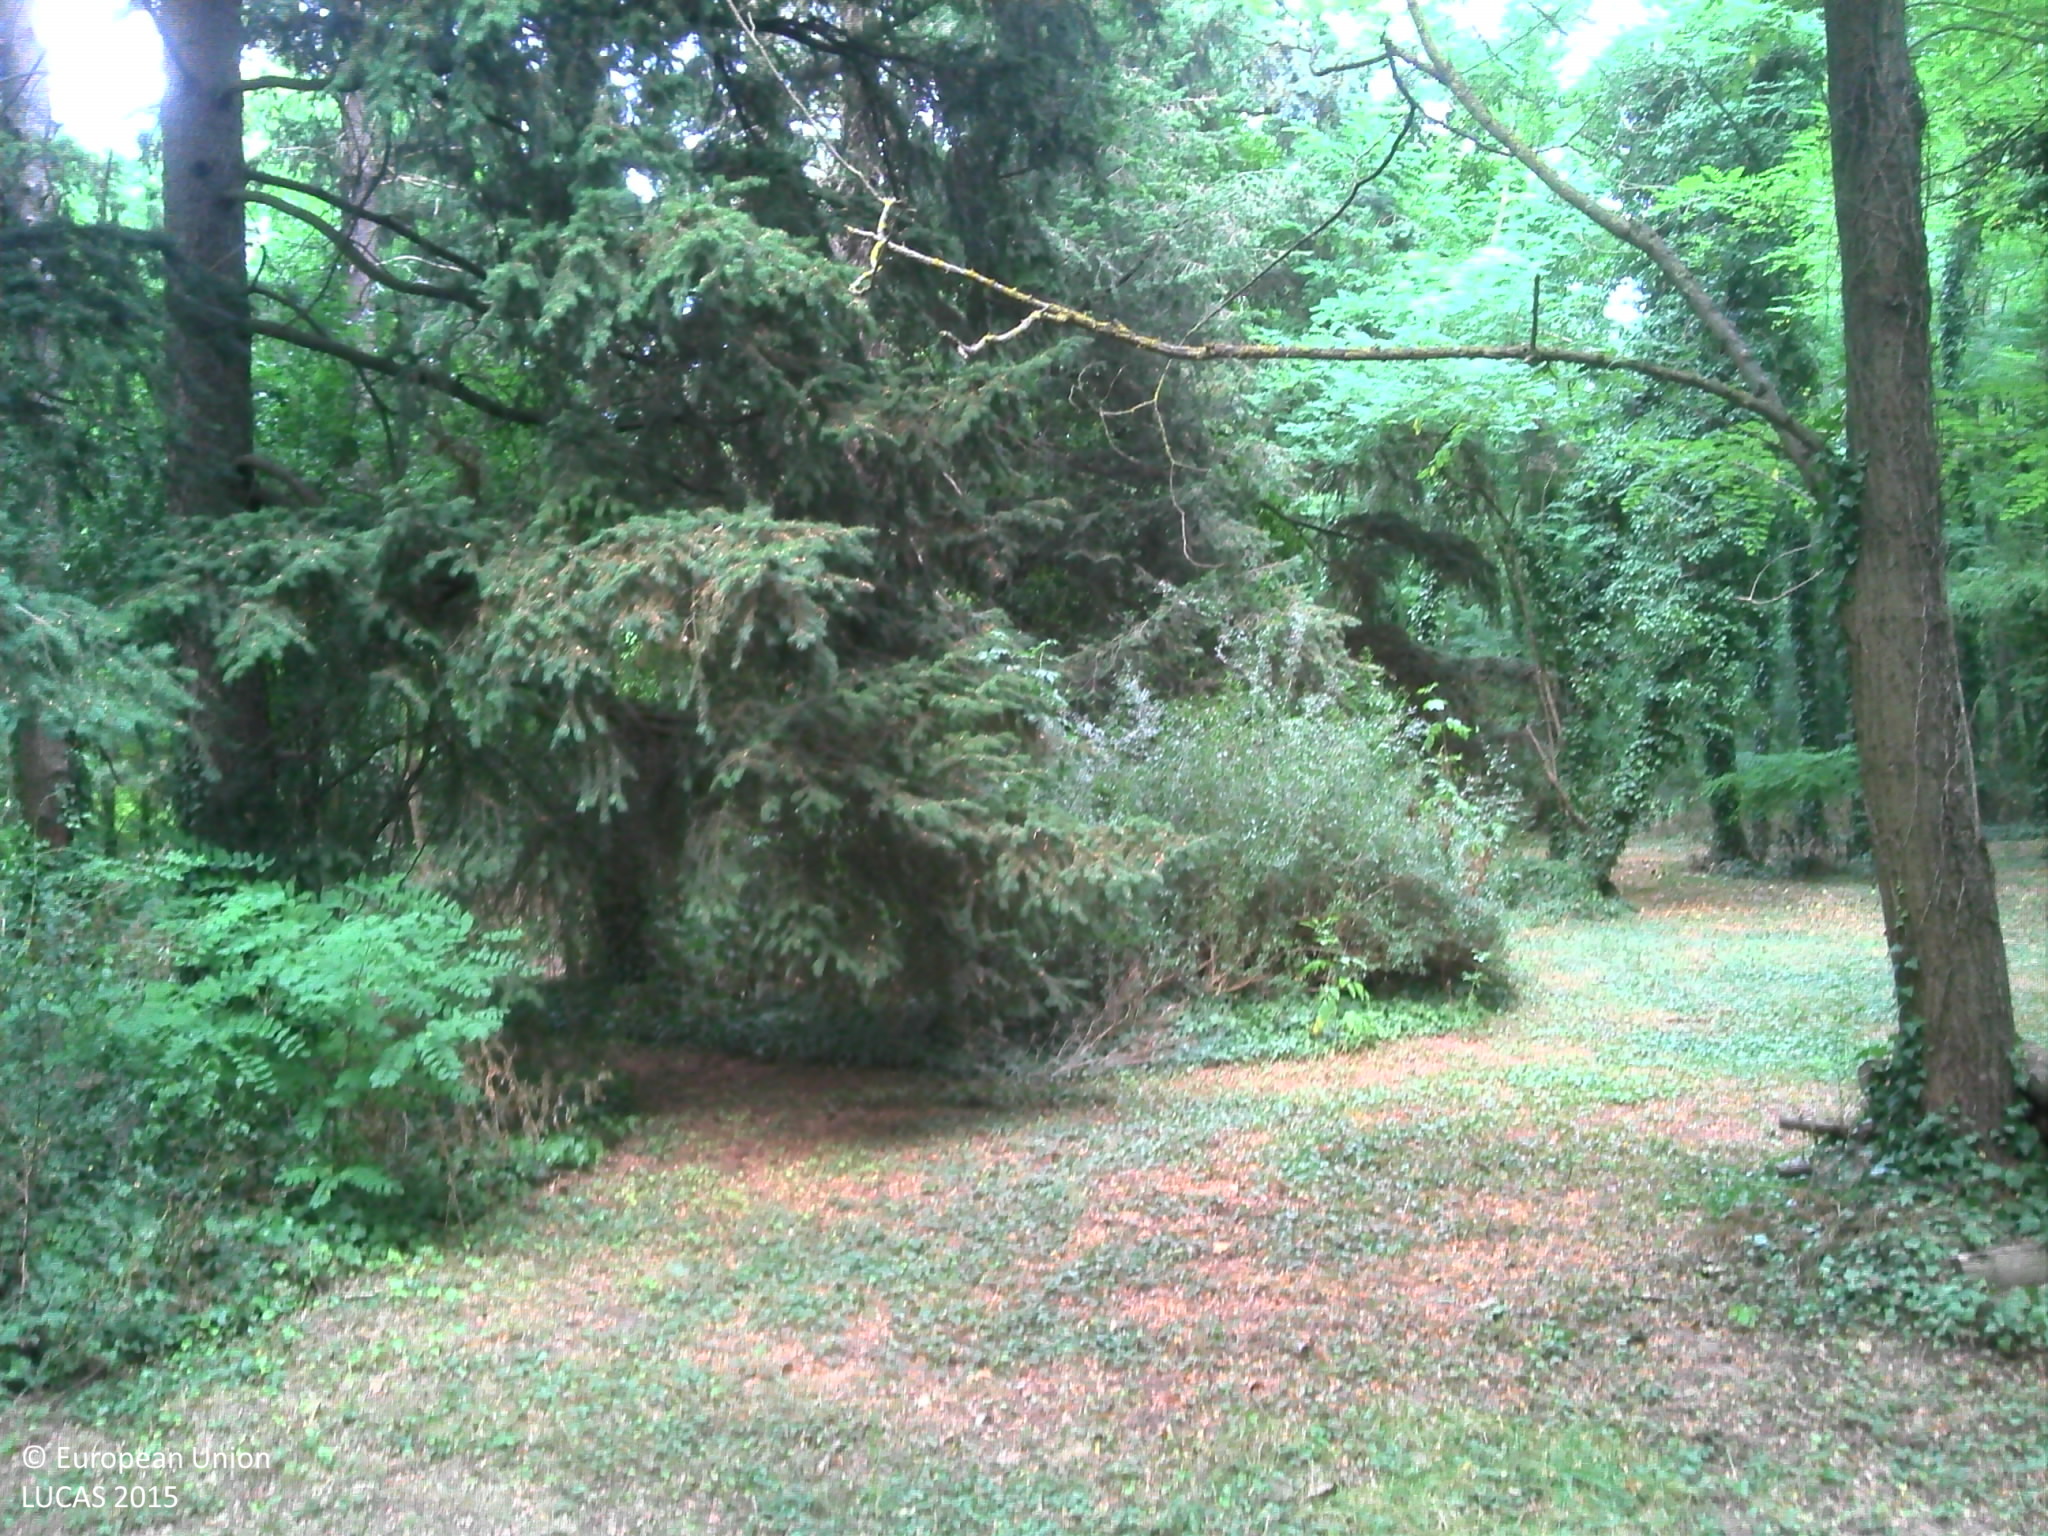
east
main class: Woodland
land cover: Other mixed woodland
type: hemiboreal forest and nemoral coniferous forest and mixed broadleaved-coniferous forest
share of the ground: > 75 %
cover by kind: coniferous forest trees 45 %, herbaceous plants 30 %, broadleaved forest trees 25 %
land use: Forestry
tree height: > 5 m
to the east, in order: Other mixed woodland; Fences; Tracks; Broadleaved woodland; Grassland without tree/shrub cover; Spontaneously vegetated surfaces; Ditches and canals; Maize
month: July
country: FR
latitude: 46.8456
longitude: 4.9526
